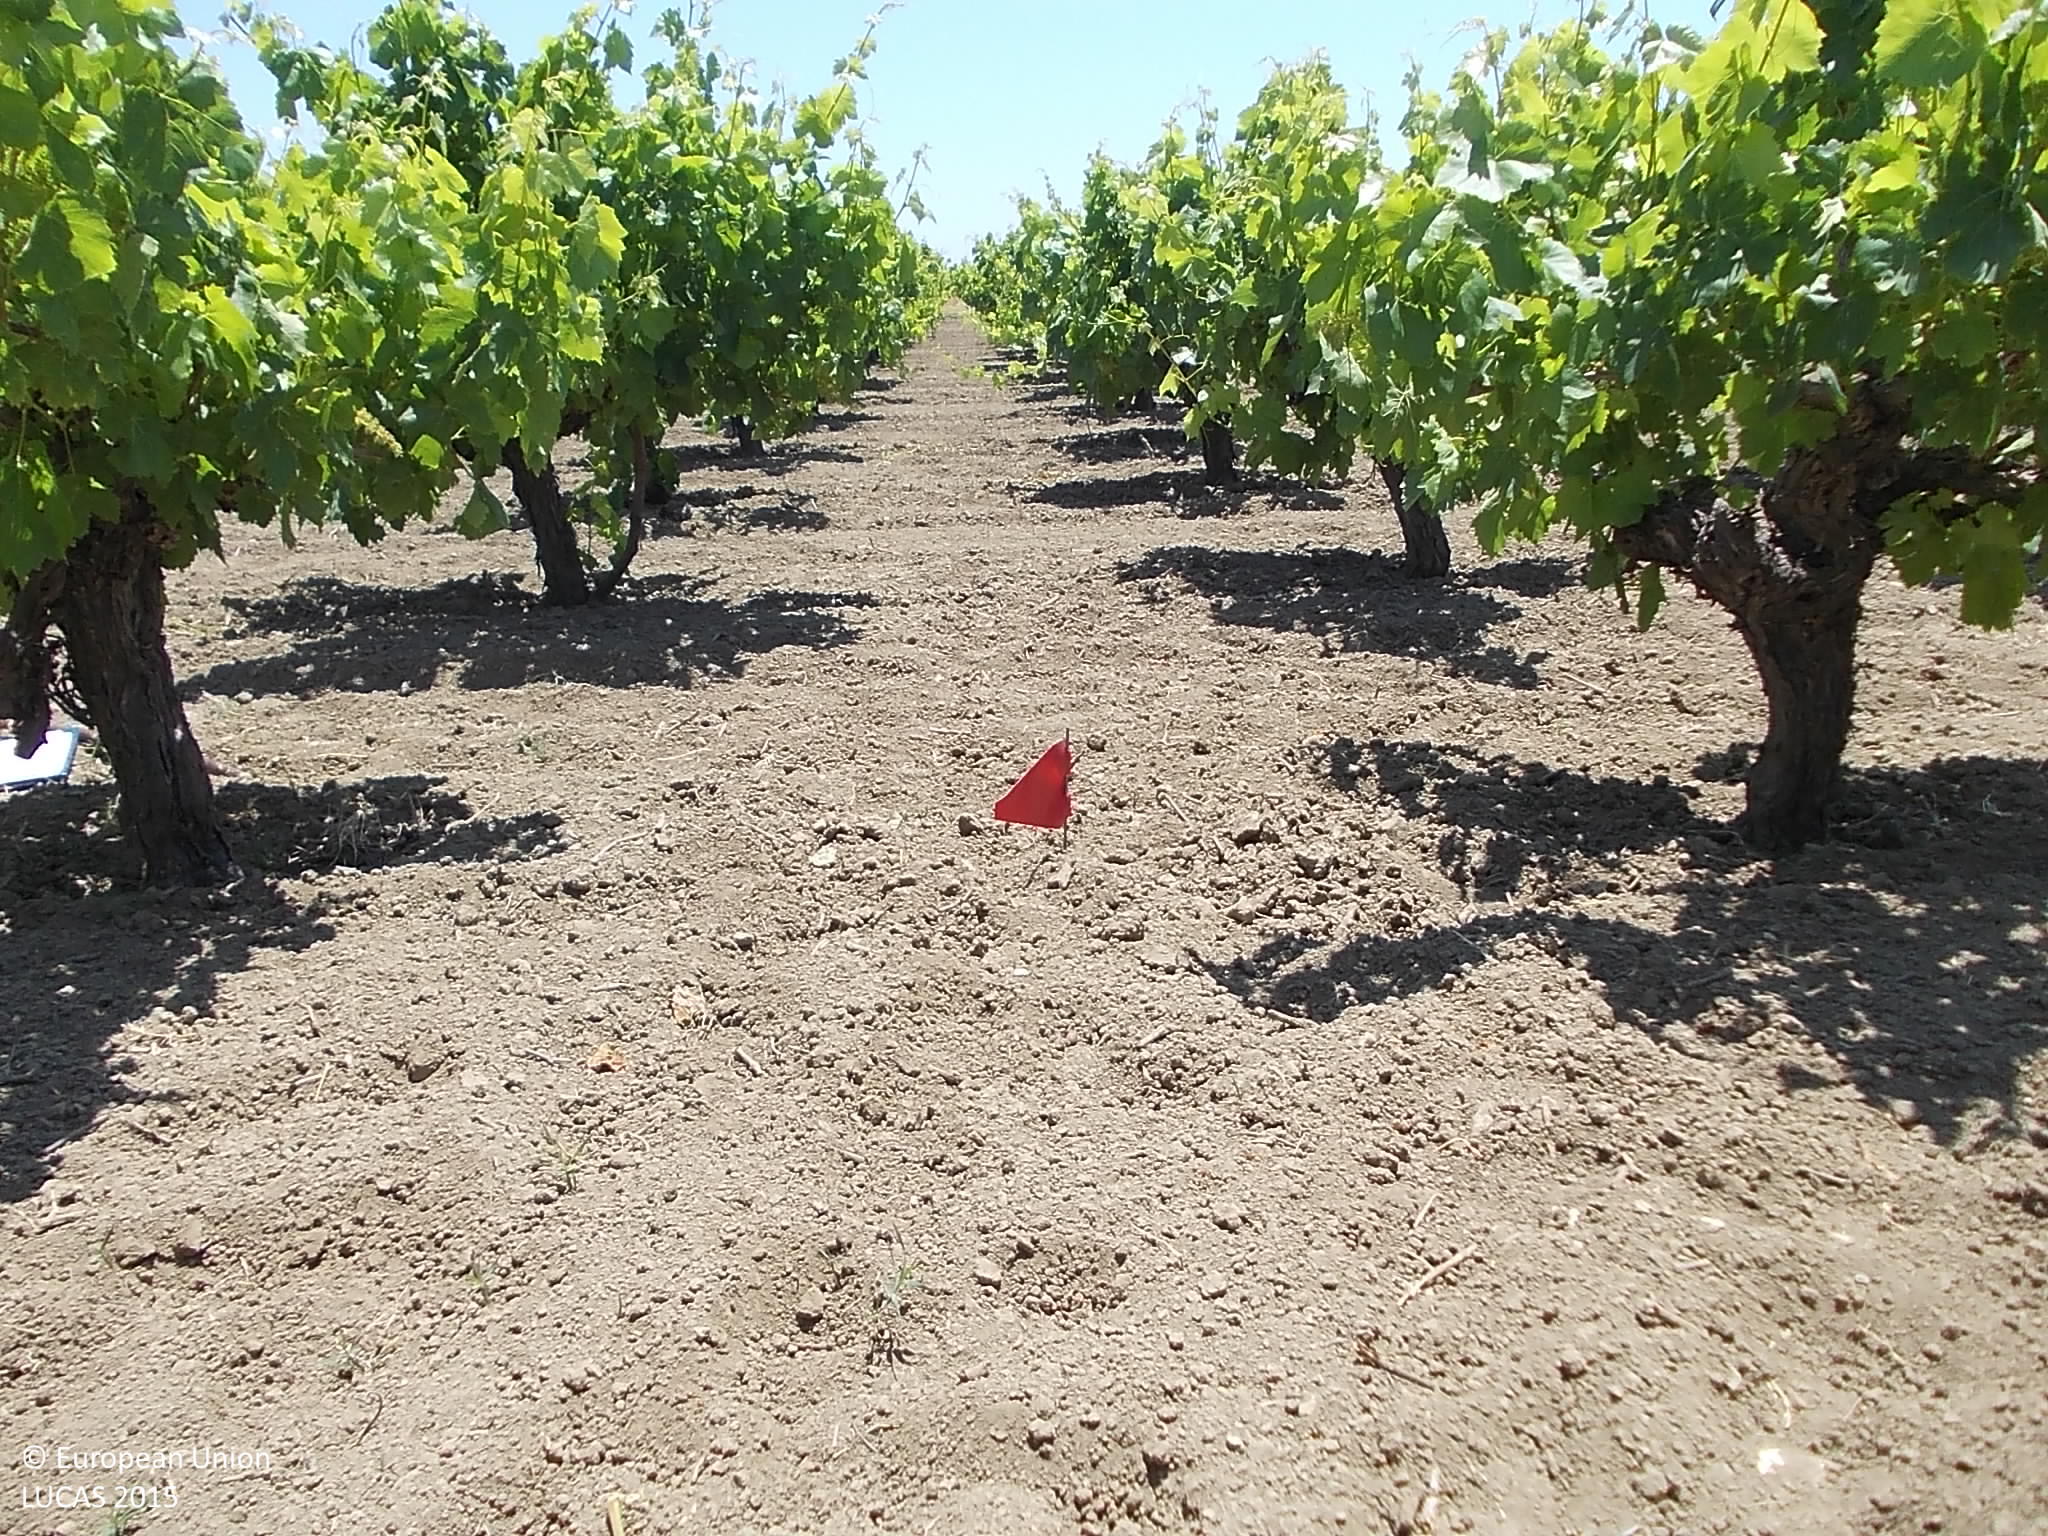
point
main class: Cropland
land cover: Vineyards
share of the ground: 50 - 75 %
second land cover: Other bare soil
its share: > 75 %
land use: Agriculture (excluding fallow land and kitchen gardens)
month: May
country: CY
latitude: 34.6690
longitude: 32.7542
